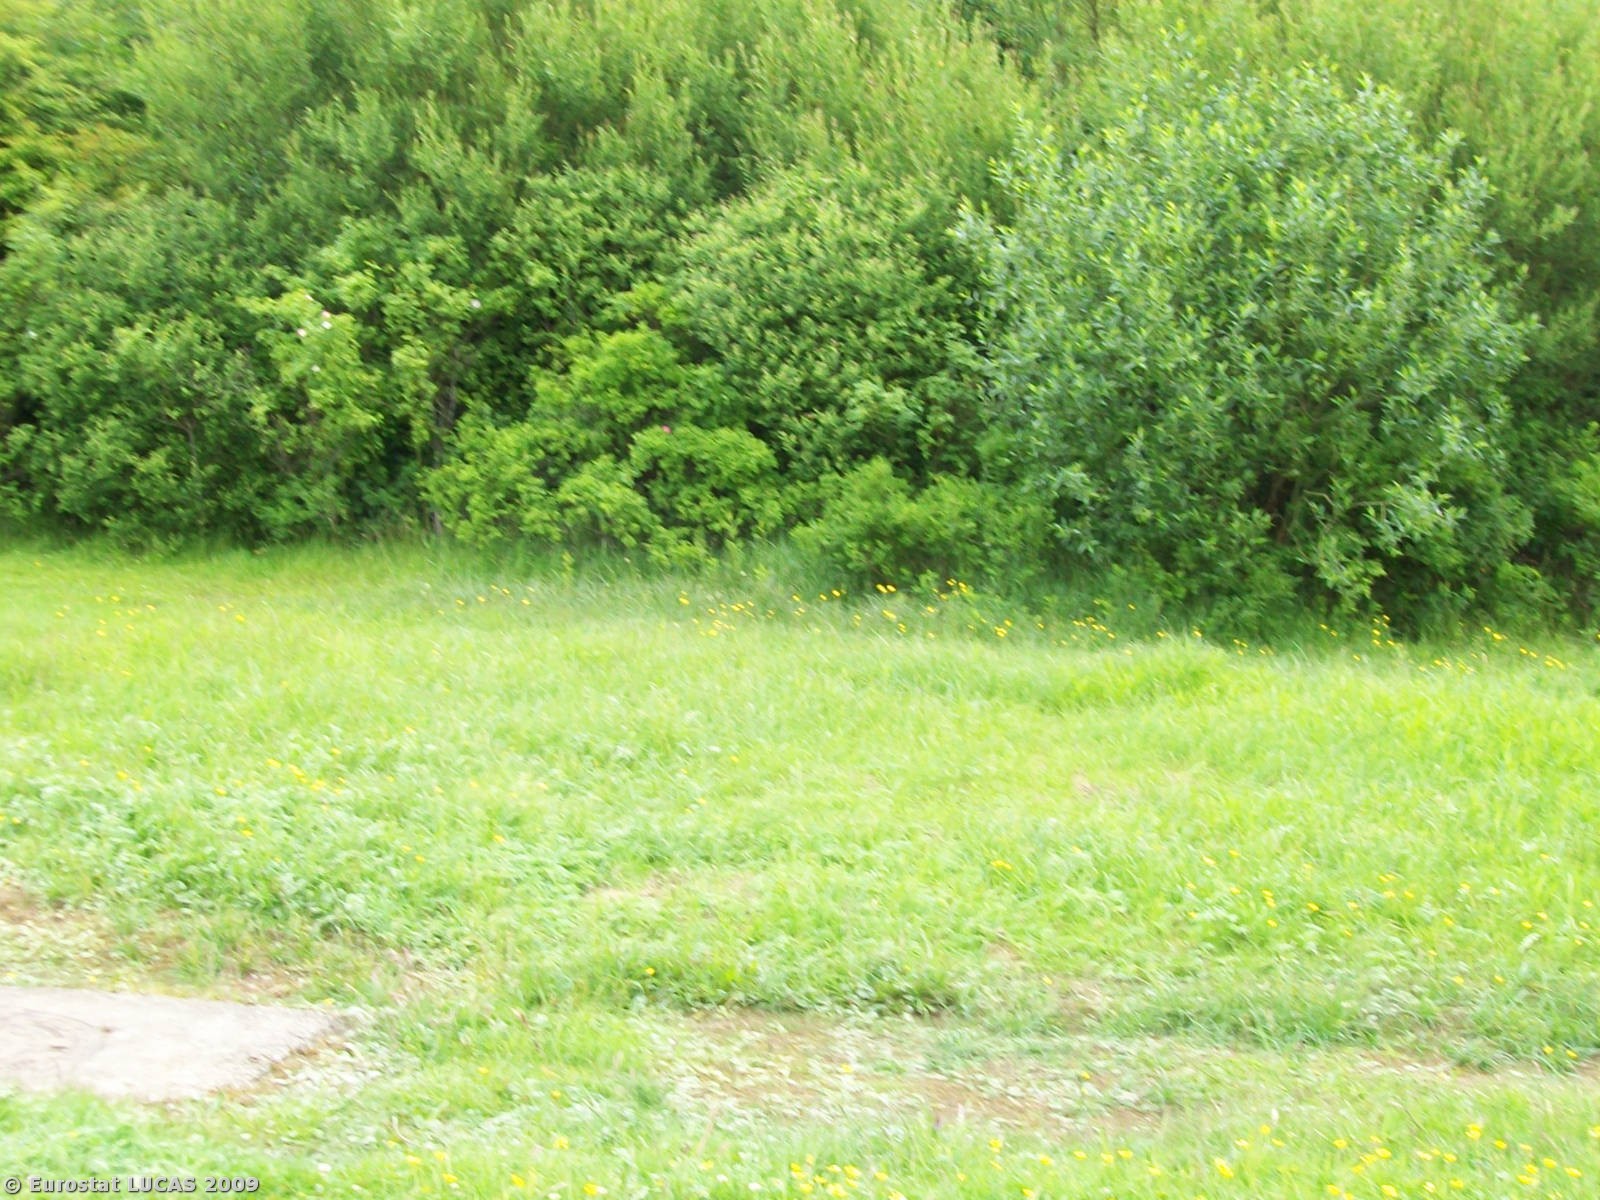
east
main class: Grassland
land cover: Grassland with sparse tree/shrub cover
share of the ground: < 10 %
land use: Amenities, museums, leisure
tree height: > 5 m
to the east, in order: Grassland with sparse tree/shrub cover; Tracks; Grassland without tree/shrub cover; Broadleaved woodland; Grass margins; Broadleaved woodland; Grass margins; Tracks
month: June
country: GB
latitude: 53.4099
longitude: -2.8128
